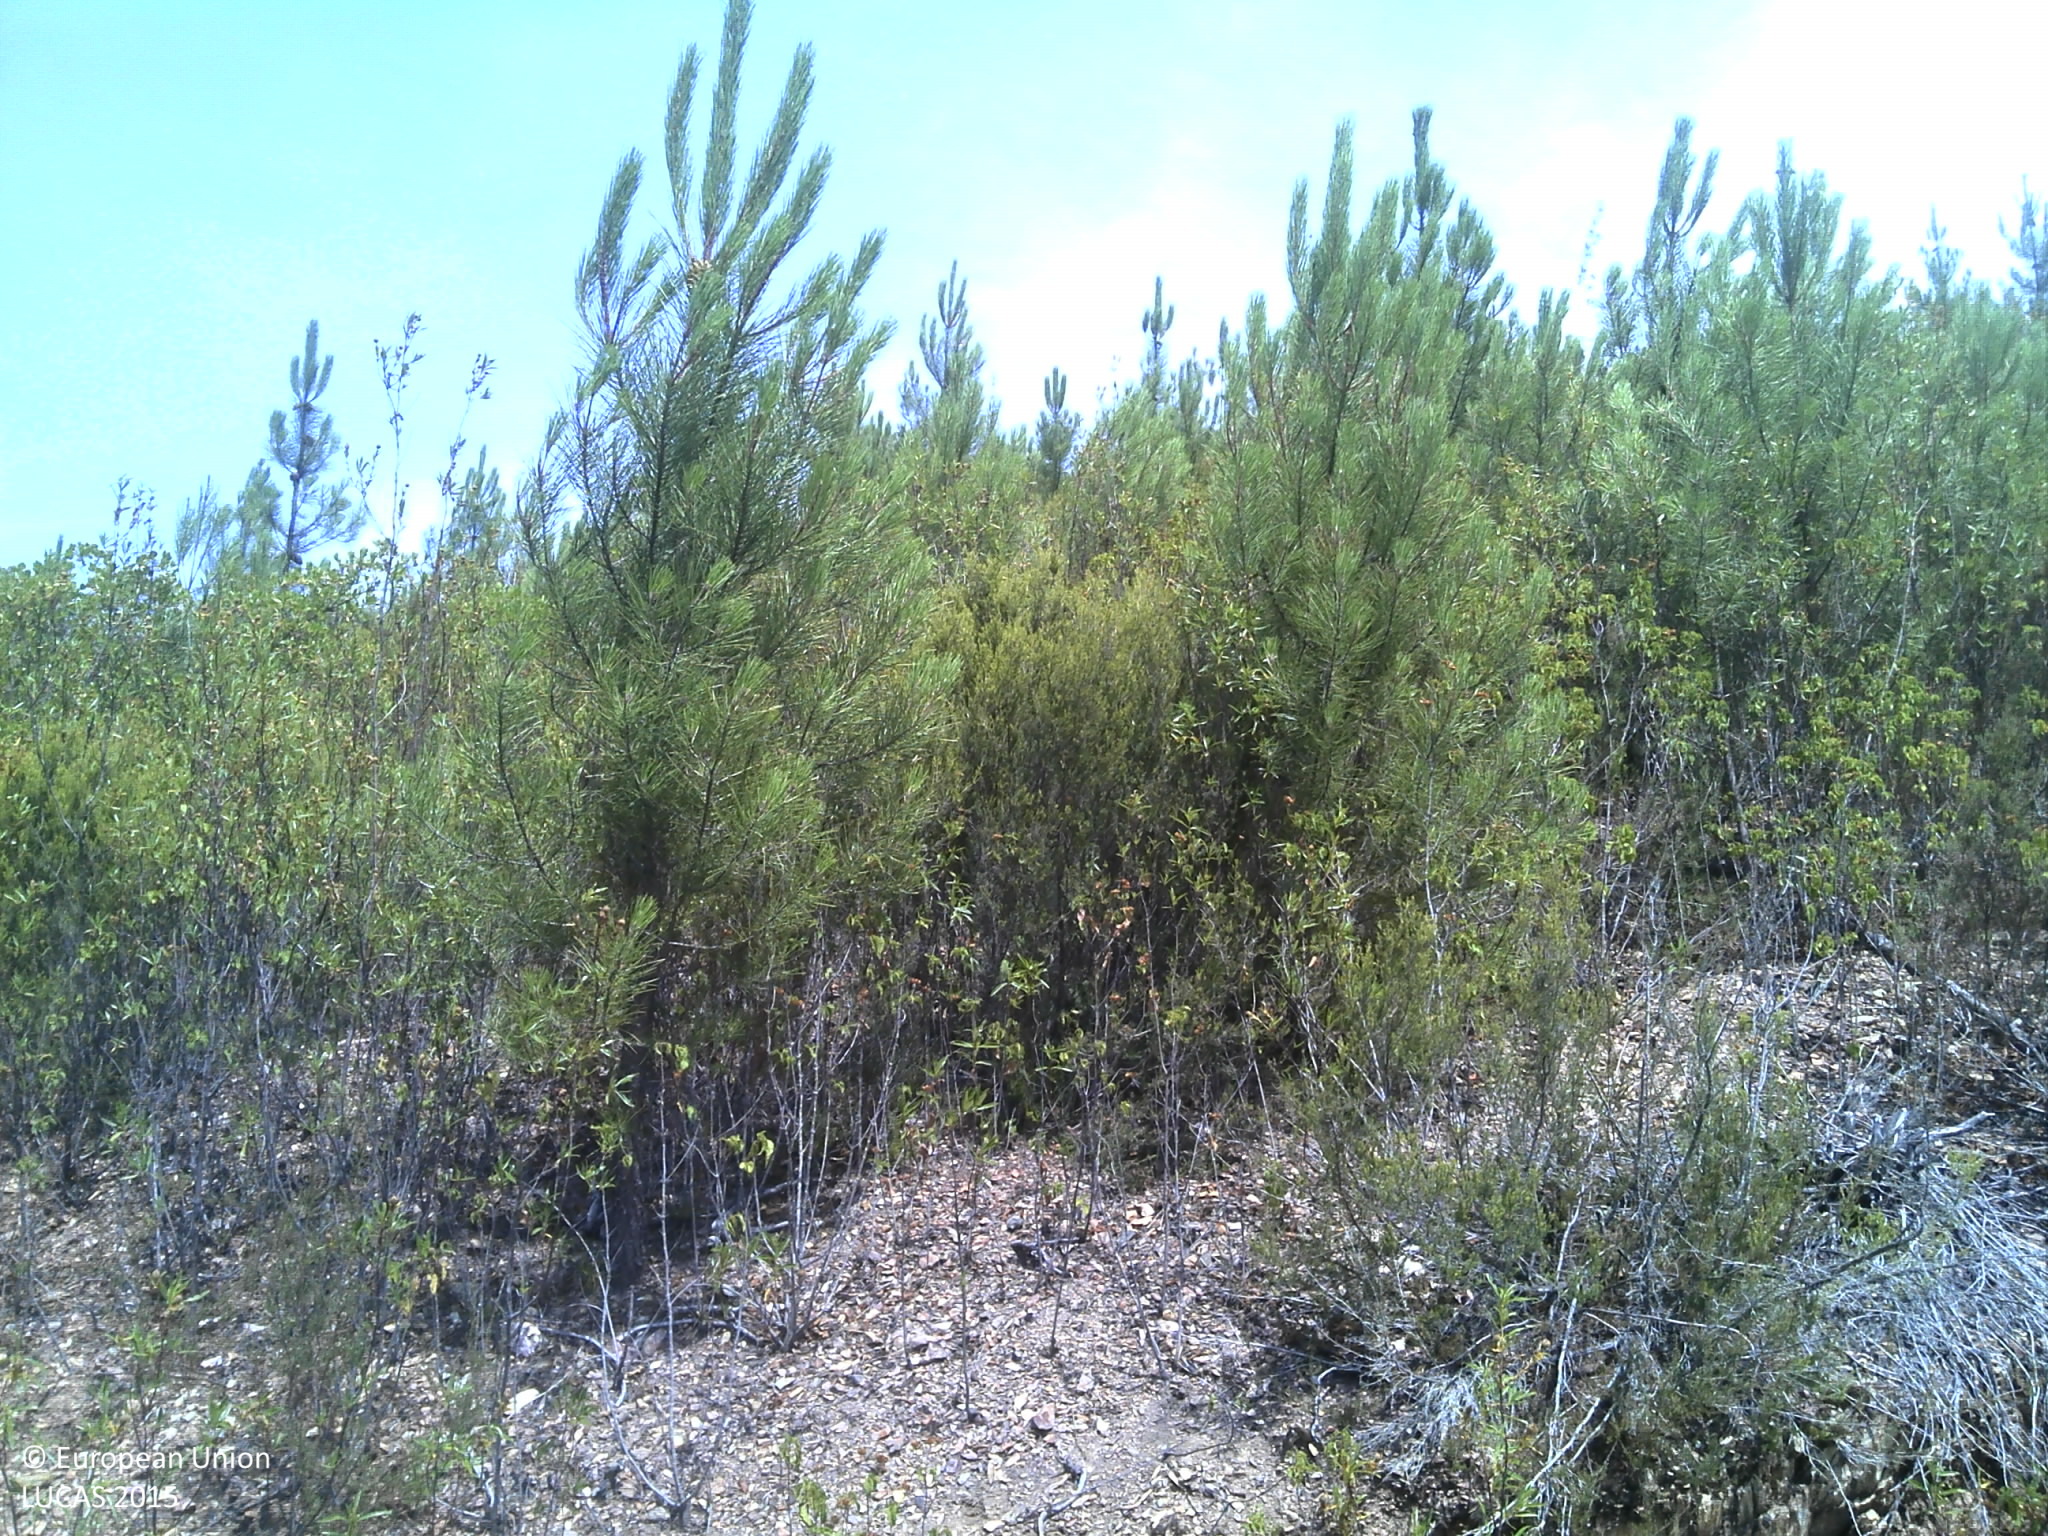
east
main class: Shrubland
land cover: Shrubland with sparse tree cover
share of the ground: 50 - 75 %
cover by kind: shrubs 75 %, unconsolidated bare surface 20 %, coniferous forest trees 5 %
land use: Semi-natural and natural areas not in use
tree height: < 5 m
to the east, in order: Shrubland with sparse tree cover; Broadleaved woodland; Rivers and streams; Shruby margins; Shrubland without tree cover; Tracks; Shrubland without tree cover; Shrubland with sparse tree cover
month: July
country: PT
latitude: 40.0347
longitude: -7.8668
